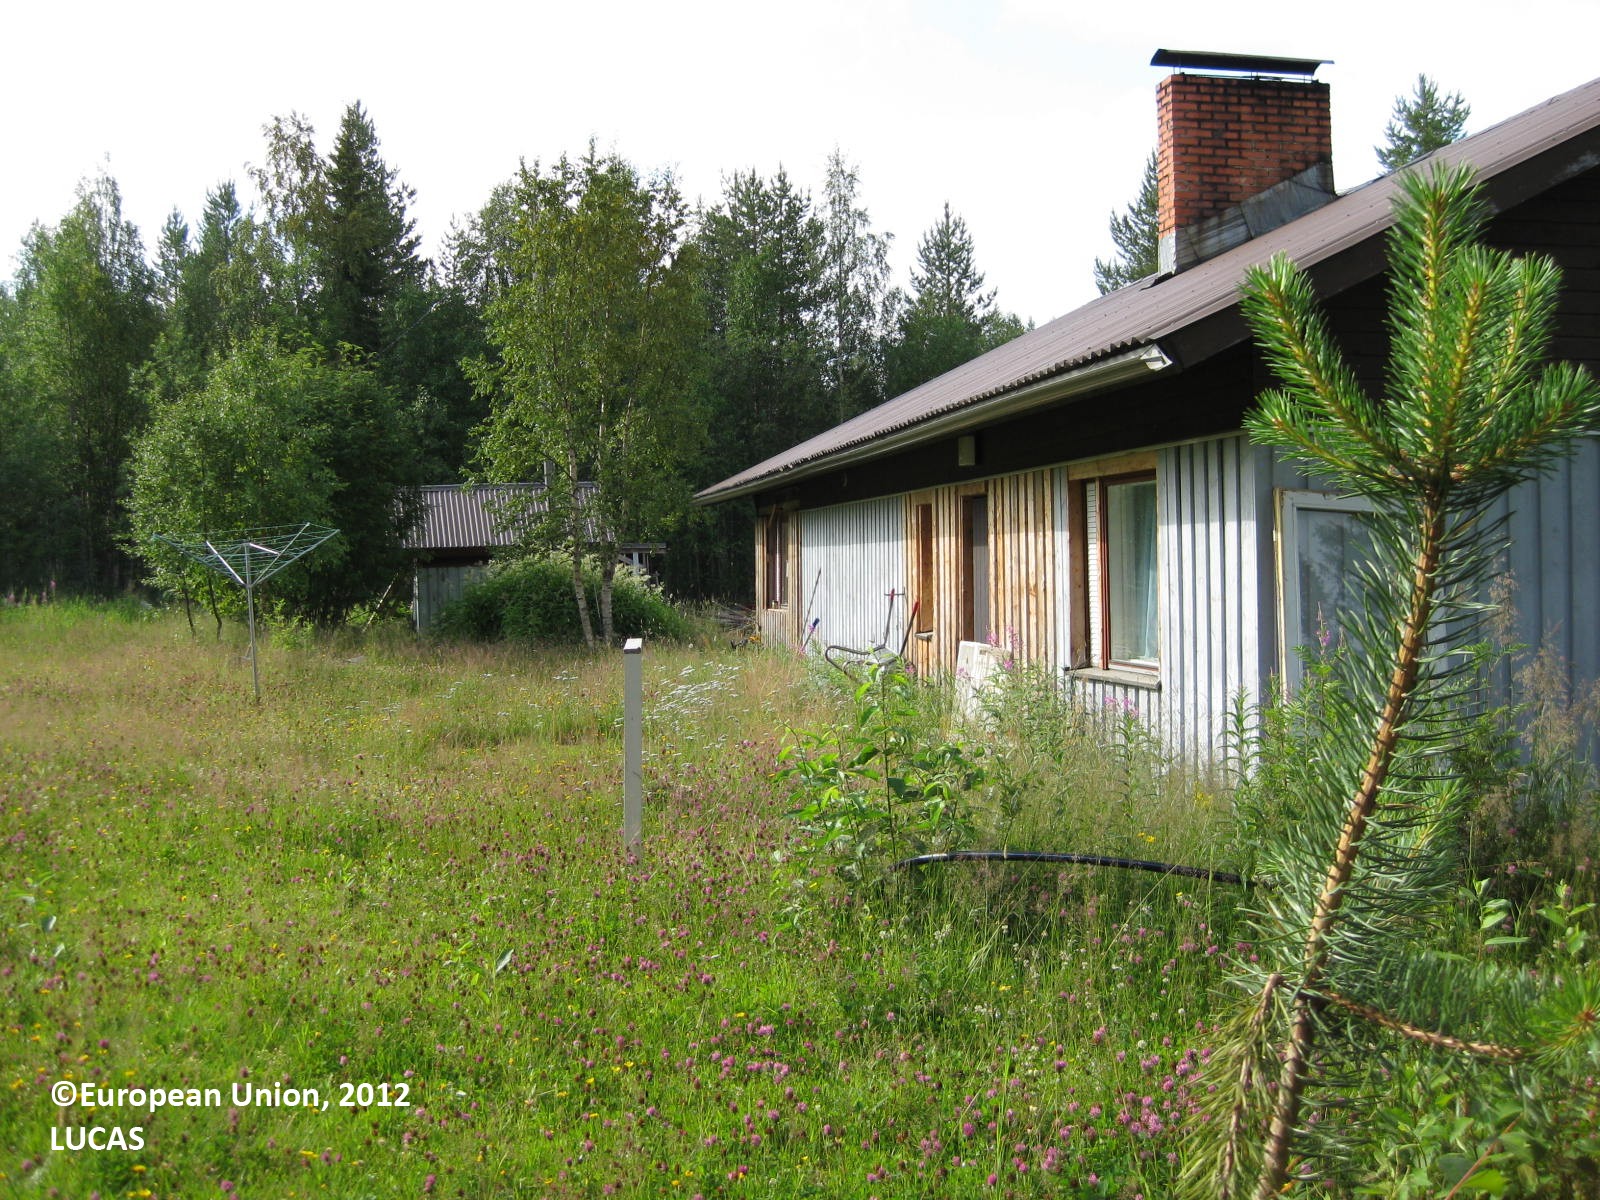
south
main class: Grassland
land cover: Grassland with sparse tree/shrub cover
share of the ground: > 75 %
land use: Residential
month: July
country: FI
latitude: 65.8389
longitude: 28.4821
